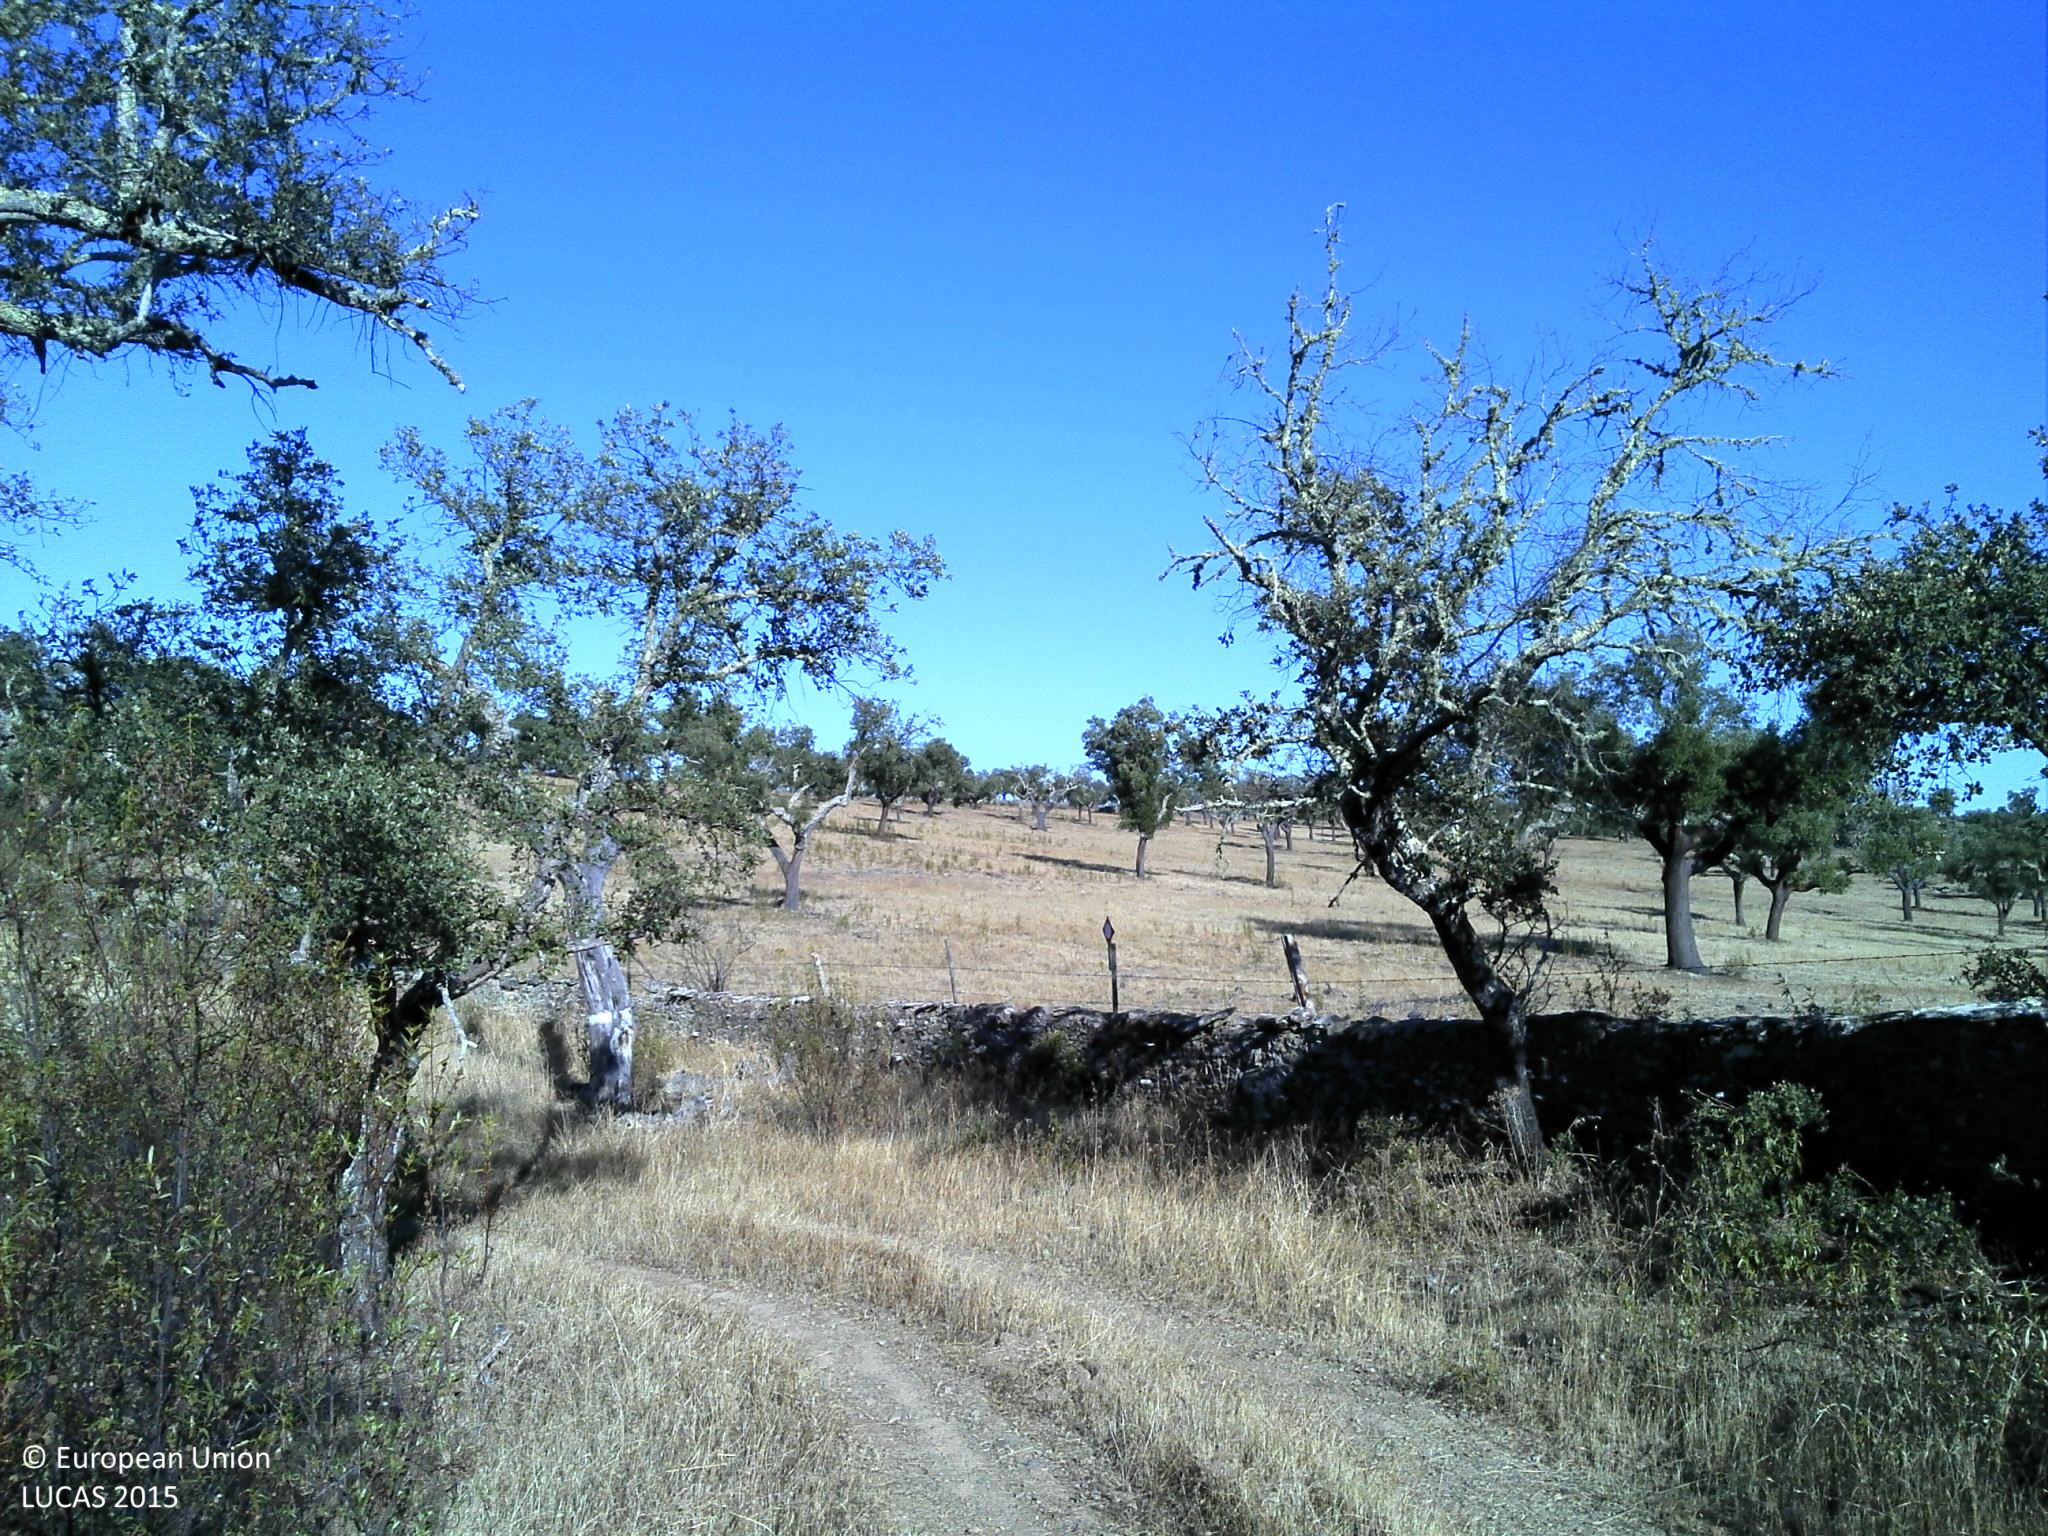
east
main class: Woodland
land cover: Broadleaved woodland
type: broadleaved evergreen forest
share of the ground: 10 - 25 %
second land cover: Shrubland without tree cover
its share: > 75 %
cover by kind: shrubs 85 %, broadleaved forest trees 15 %
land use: Forestry
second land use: Agriculture (excluding fallow land and kitchen gardens)
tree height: > 5 m
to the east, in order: Grass margins; Tracks; Broadleaved woodland; Shrubland without tree cover; Tracks; Dry stone walls; Fences; Broadleaved woodland; Grassland without tree/shrub cover; Broadleaved woodland; Grassland without tree/shrub cover; Broadleaved woodland
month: August
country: PT
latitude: 39.5415
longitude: -7.5371
